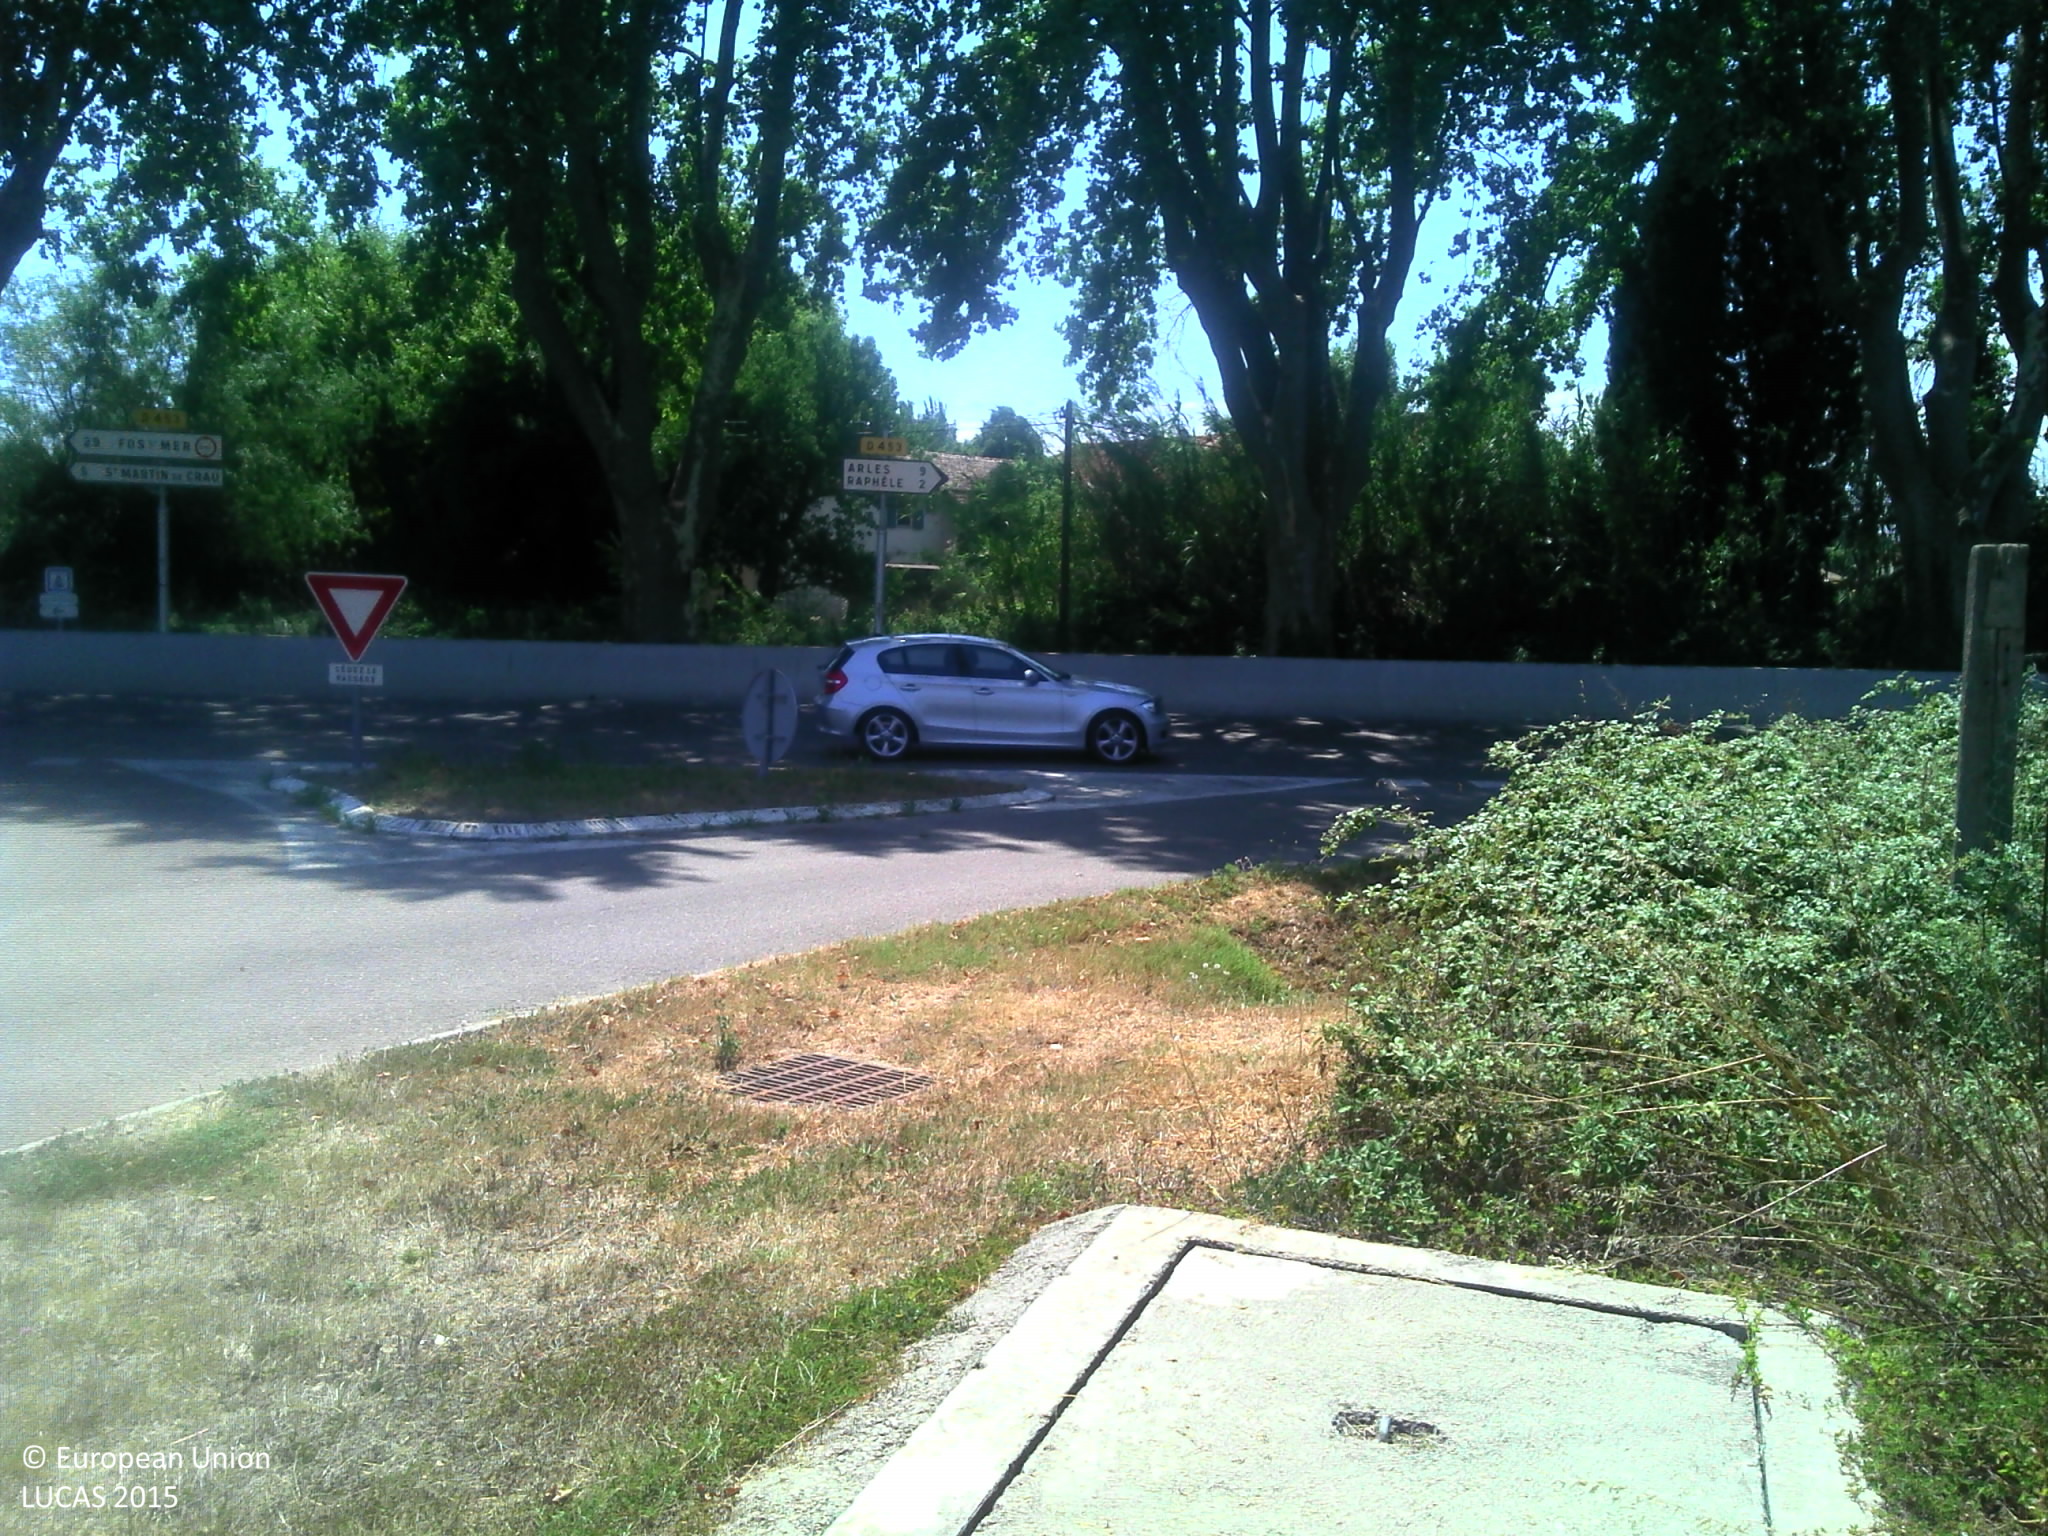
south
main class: Grassland
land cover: Grassland with sparse tree/shrub cover
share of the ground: > 75 %
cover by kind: herbaceous plants 90 %, coniferous forest trees 5 %, shrubs 5 %
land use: Agriculture (excluding fallow land and kitchen gardens)
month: July
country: FR
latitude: 43.6388
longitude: 4.7413
